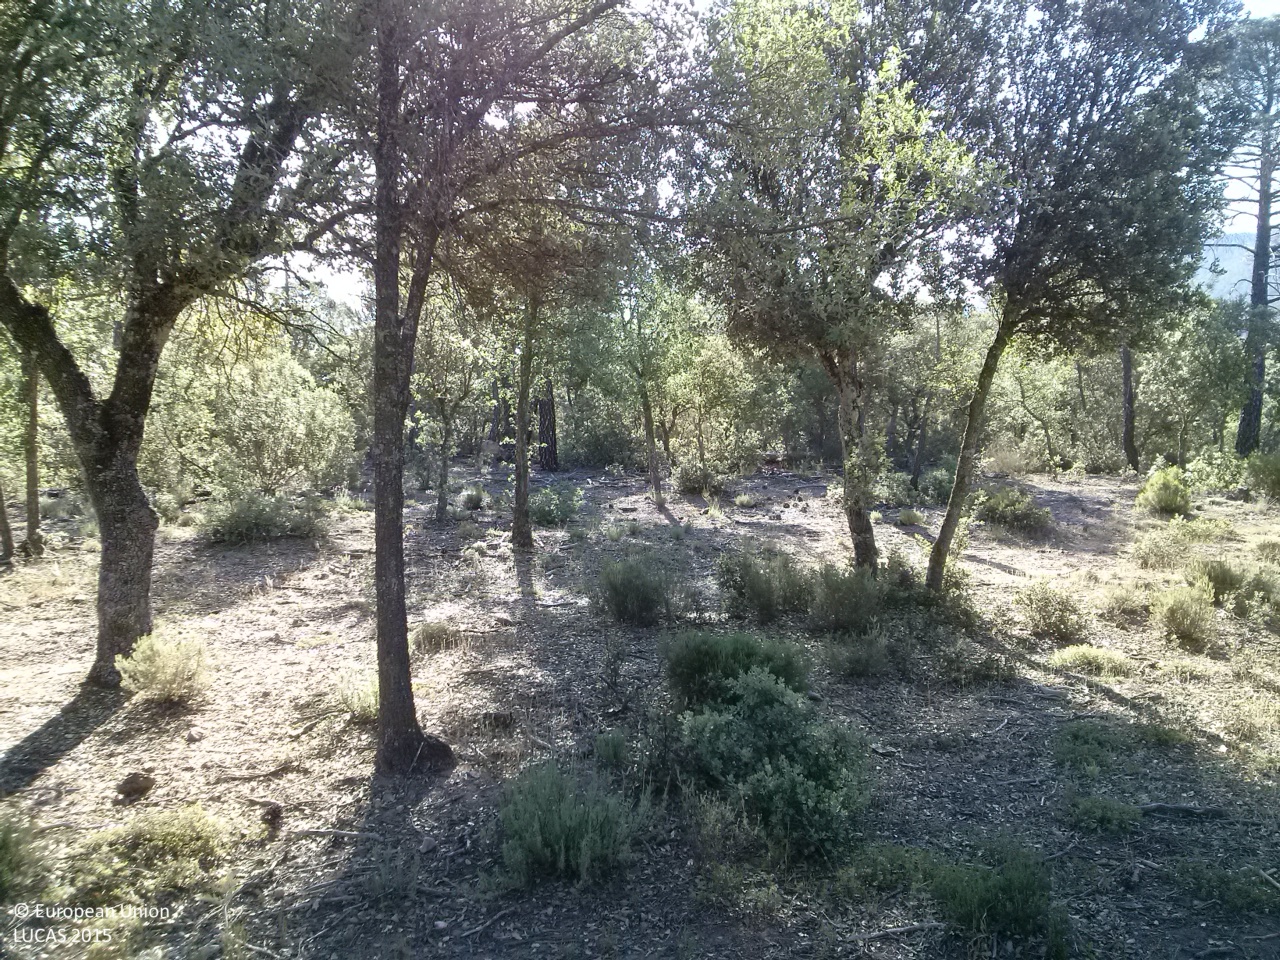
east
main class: Woodland
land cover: Other mixed woodland
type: broadleaved evergreen forest
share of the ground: 10 - 25 %
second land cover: Shrubland without tree cover
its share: 10 - 25 %
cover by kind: shrubs 25 %, herbaceous plants 25 %, unconsolidated bare surface 25 %, broadleaved forest trees 15 %, coniferous forest trees 10 %
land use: Forestry
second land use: Agriculture (excluding fallow land and kitchen gardens)
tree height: > 5 m
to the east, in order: Other mixed woodland; Shrubland without tree cover; Tracks; Other mixed woodland; Pine dominated mixed woodland; Tracks; Pine dominated mixed woodland
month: June
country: ES
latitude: 39.9506
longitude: -1.6803
